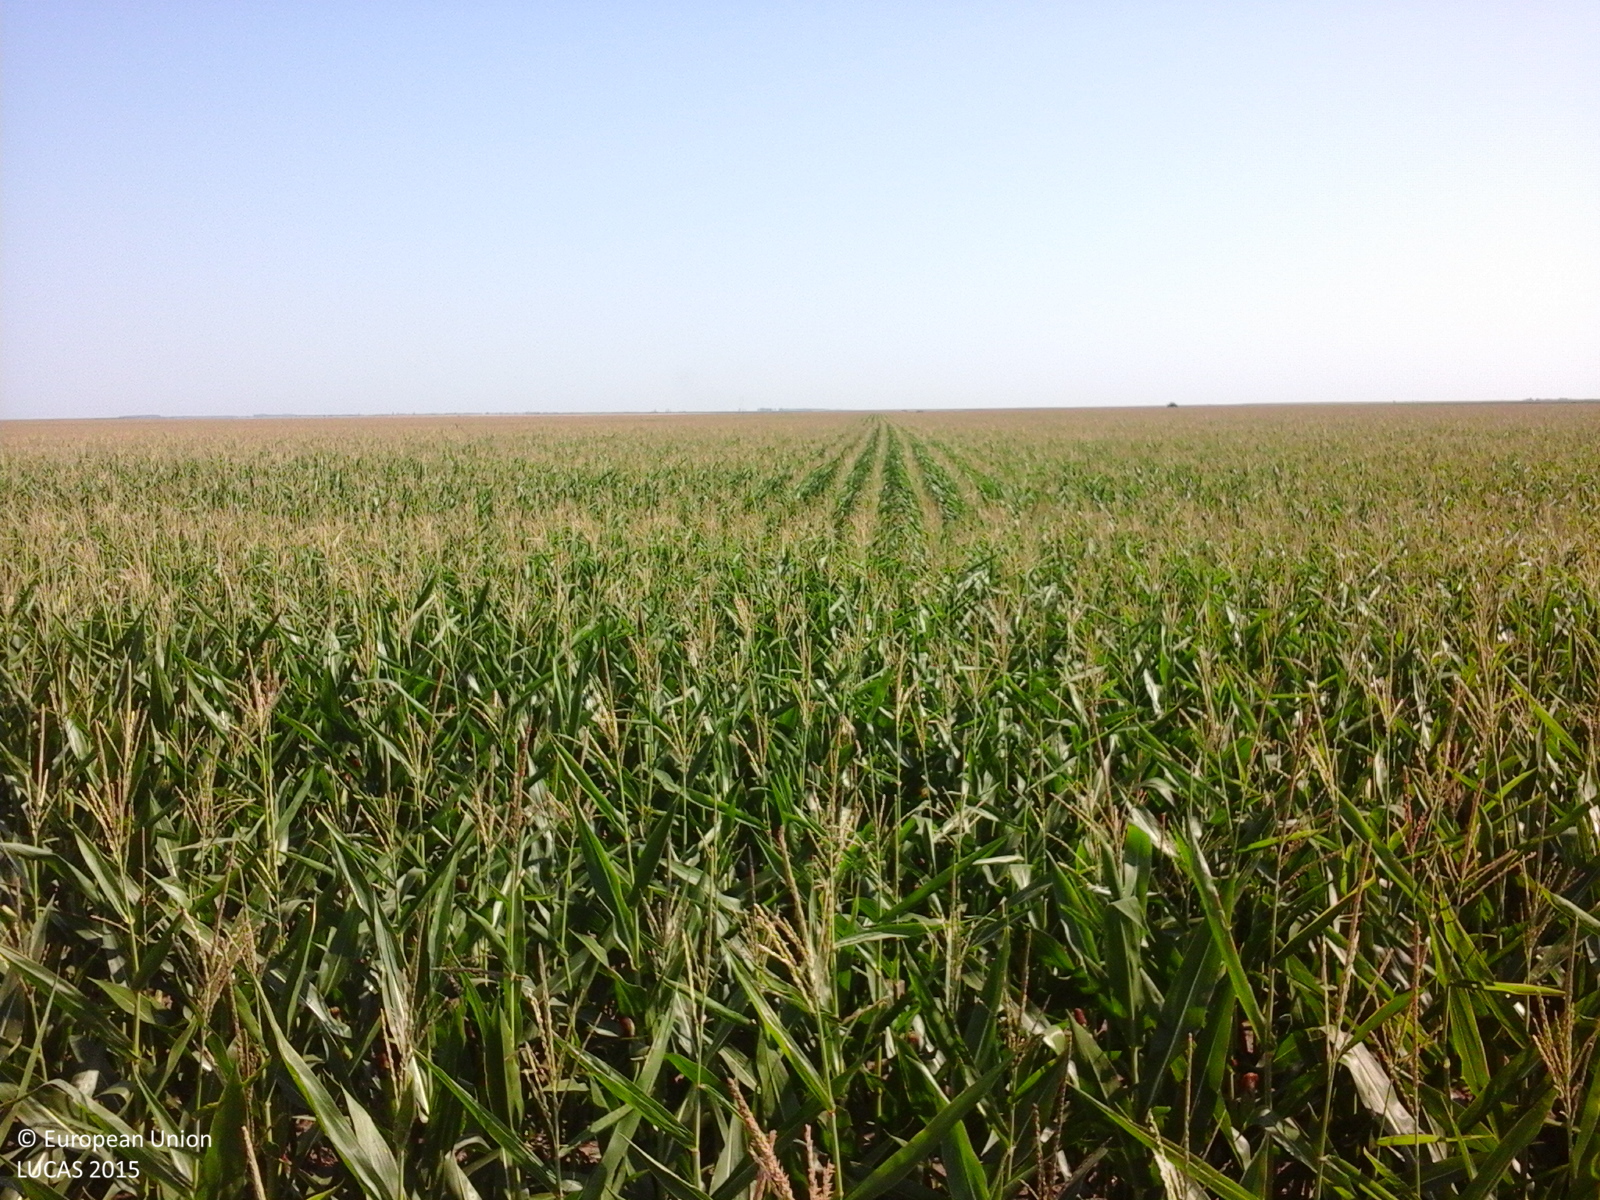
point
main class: Cropland
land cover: Maize
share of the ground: > 75 %
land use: Agriculture (excluding fallow land and kitchen gardens)
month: July
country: RO
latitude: 44.7585
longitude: 27.1004
